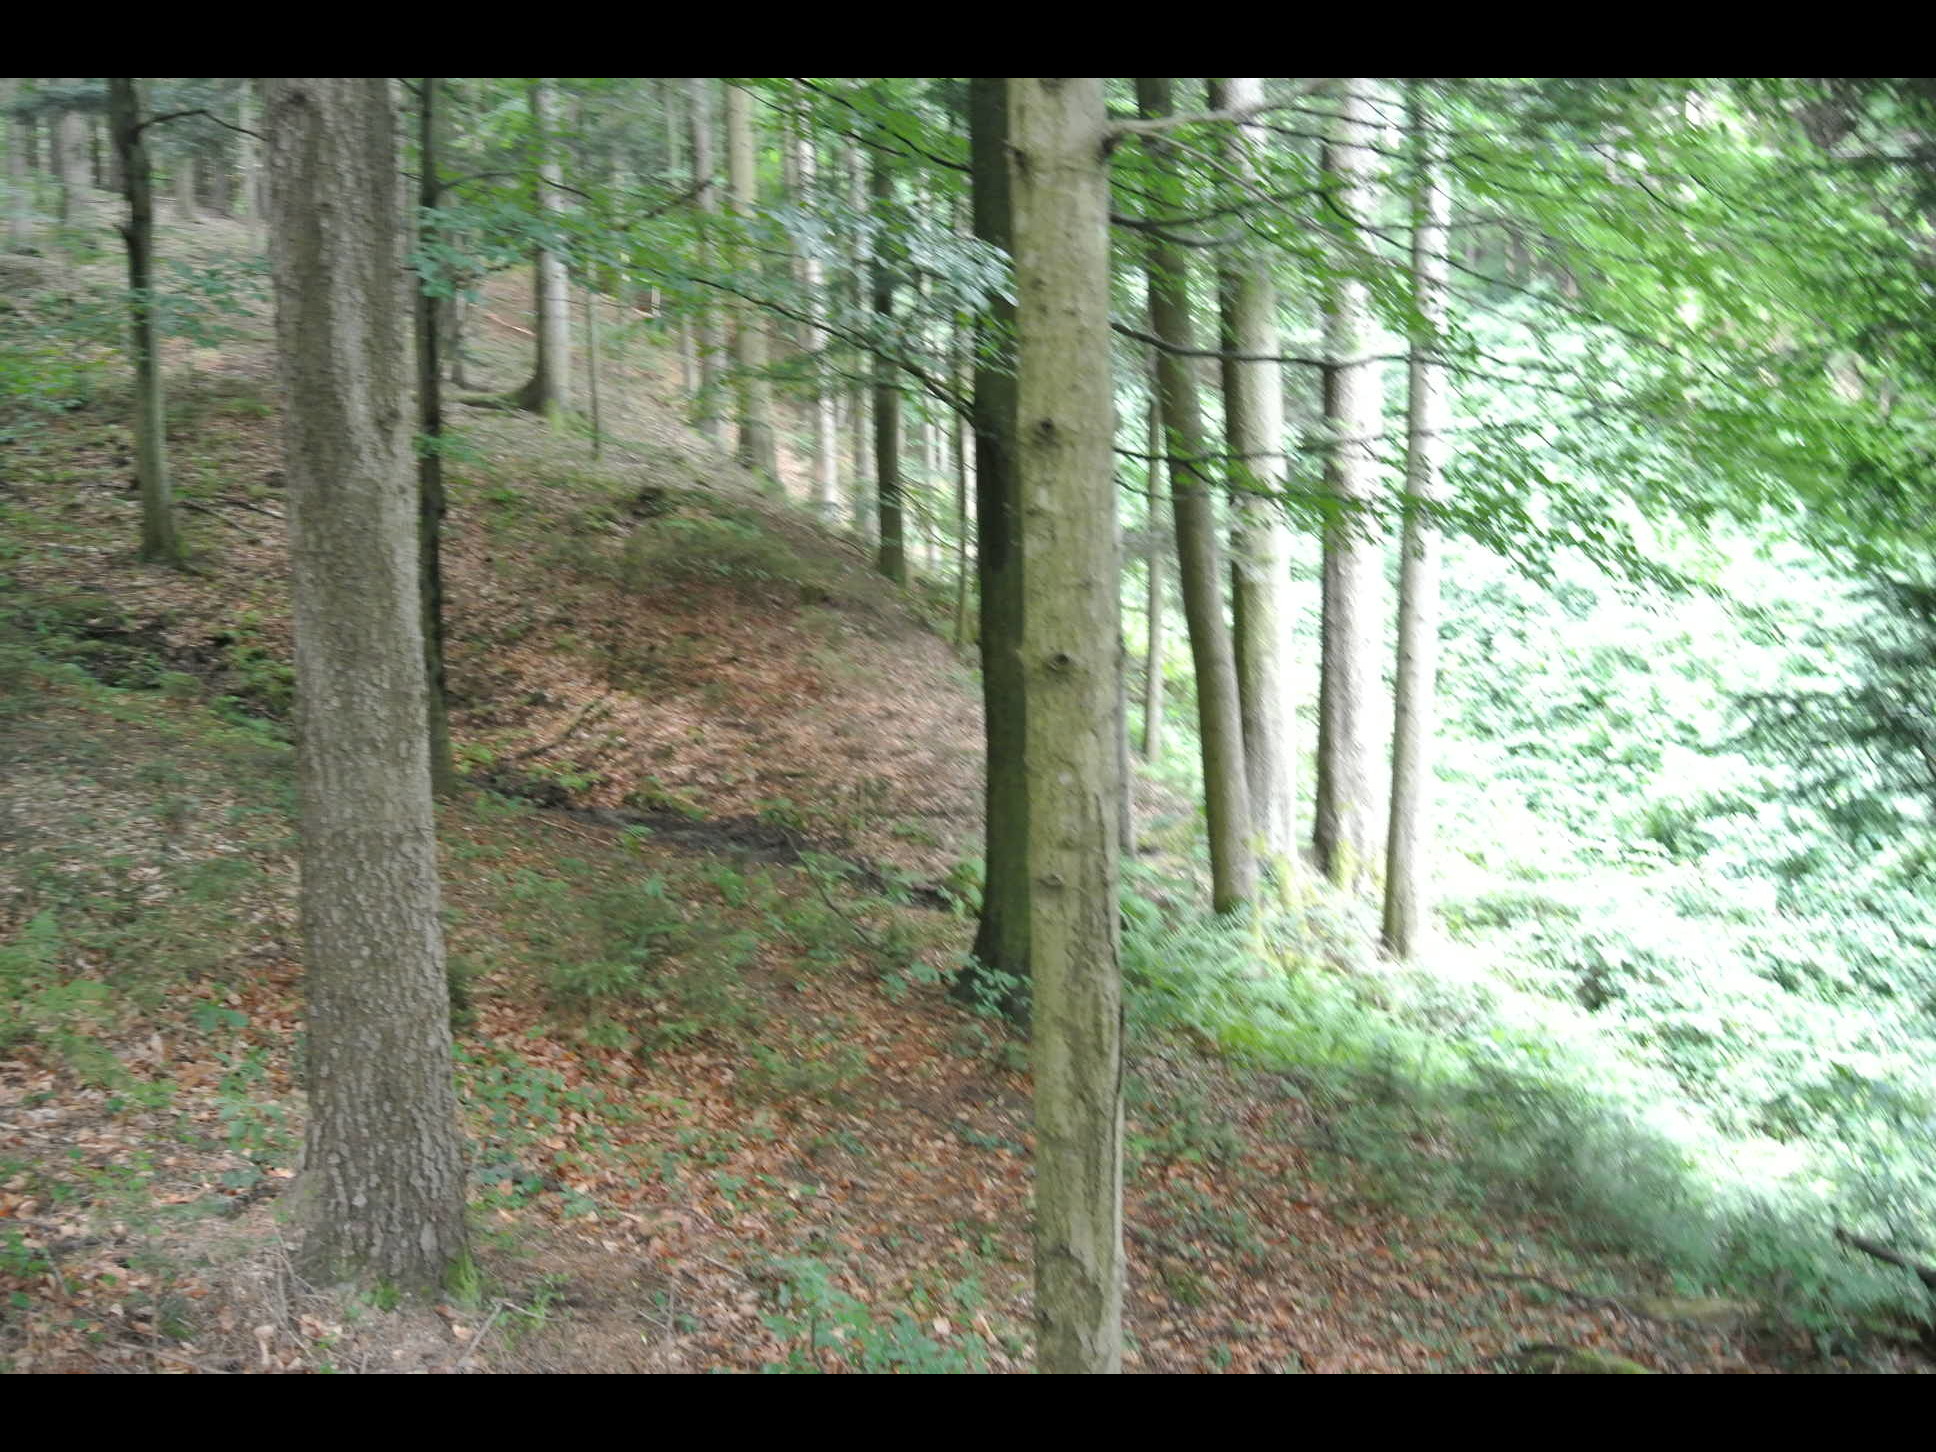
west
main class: Woodland
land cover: Spruce dominated coniferous woodland
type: alpine coniferous forest
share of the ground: > 75 %
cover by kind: coniferous forest trees 75 %, broadleaved forest trees 20 %, herbaceous plants 5 %
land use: Forestry
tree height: > 5 m
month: July
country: AT
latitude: 47.6209
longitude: 16.1101
